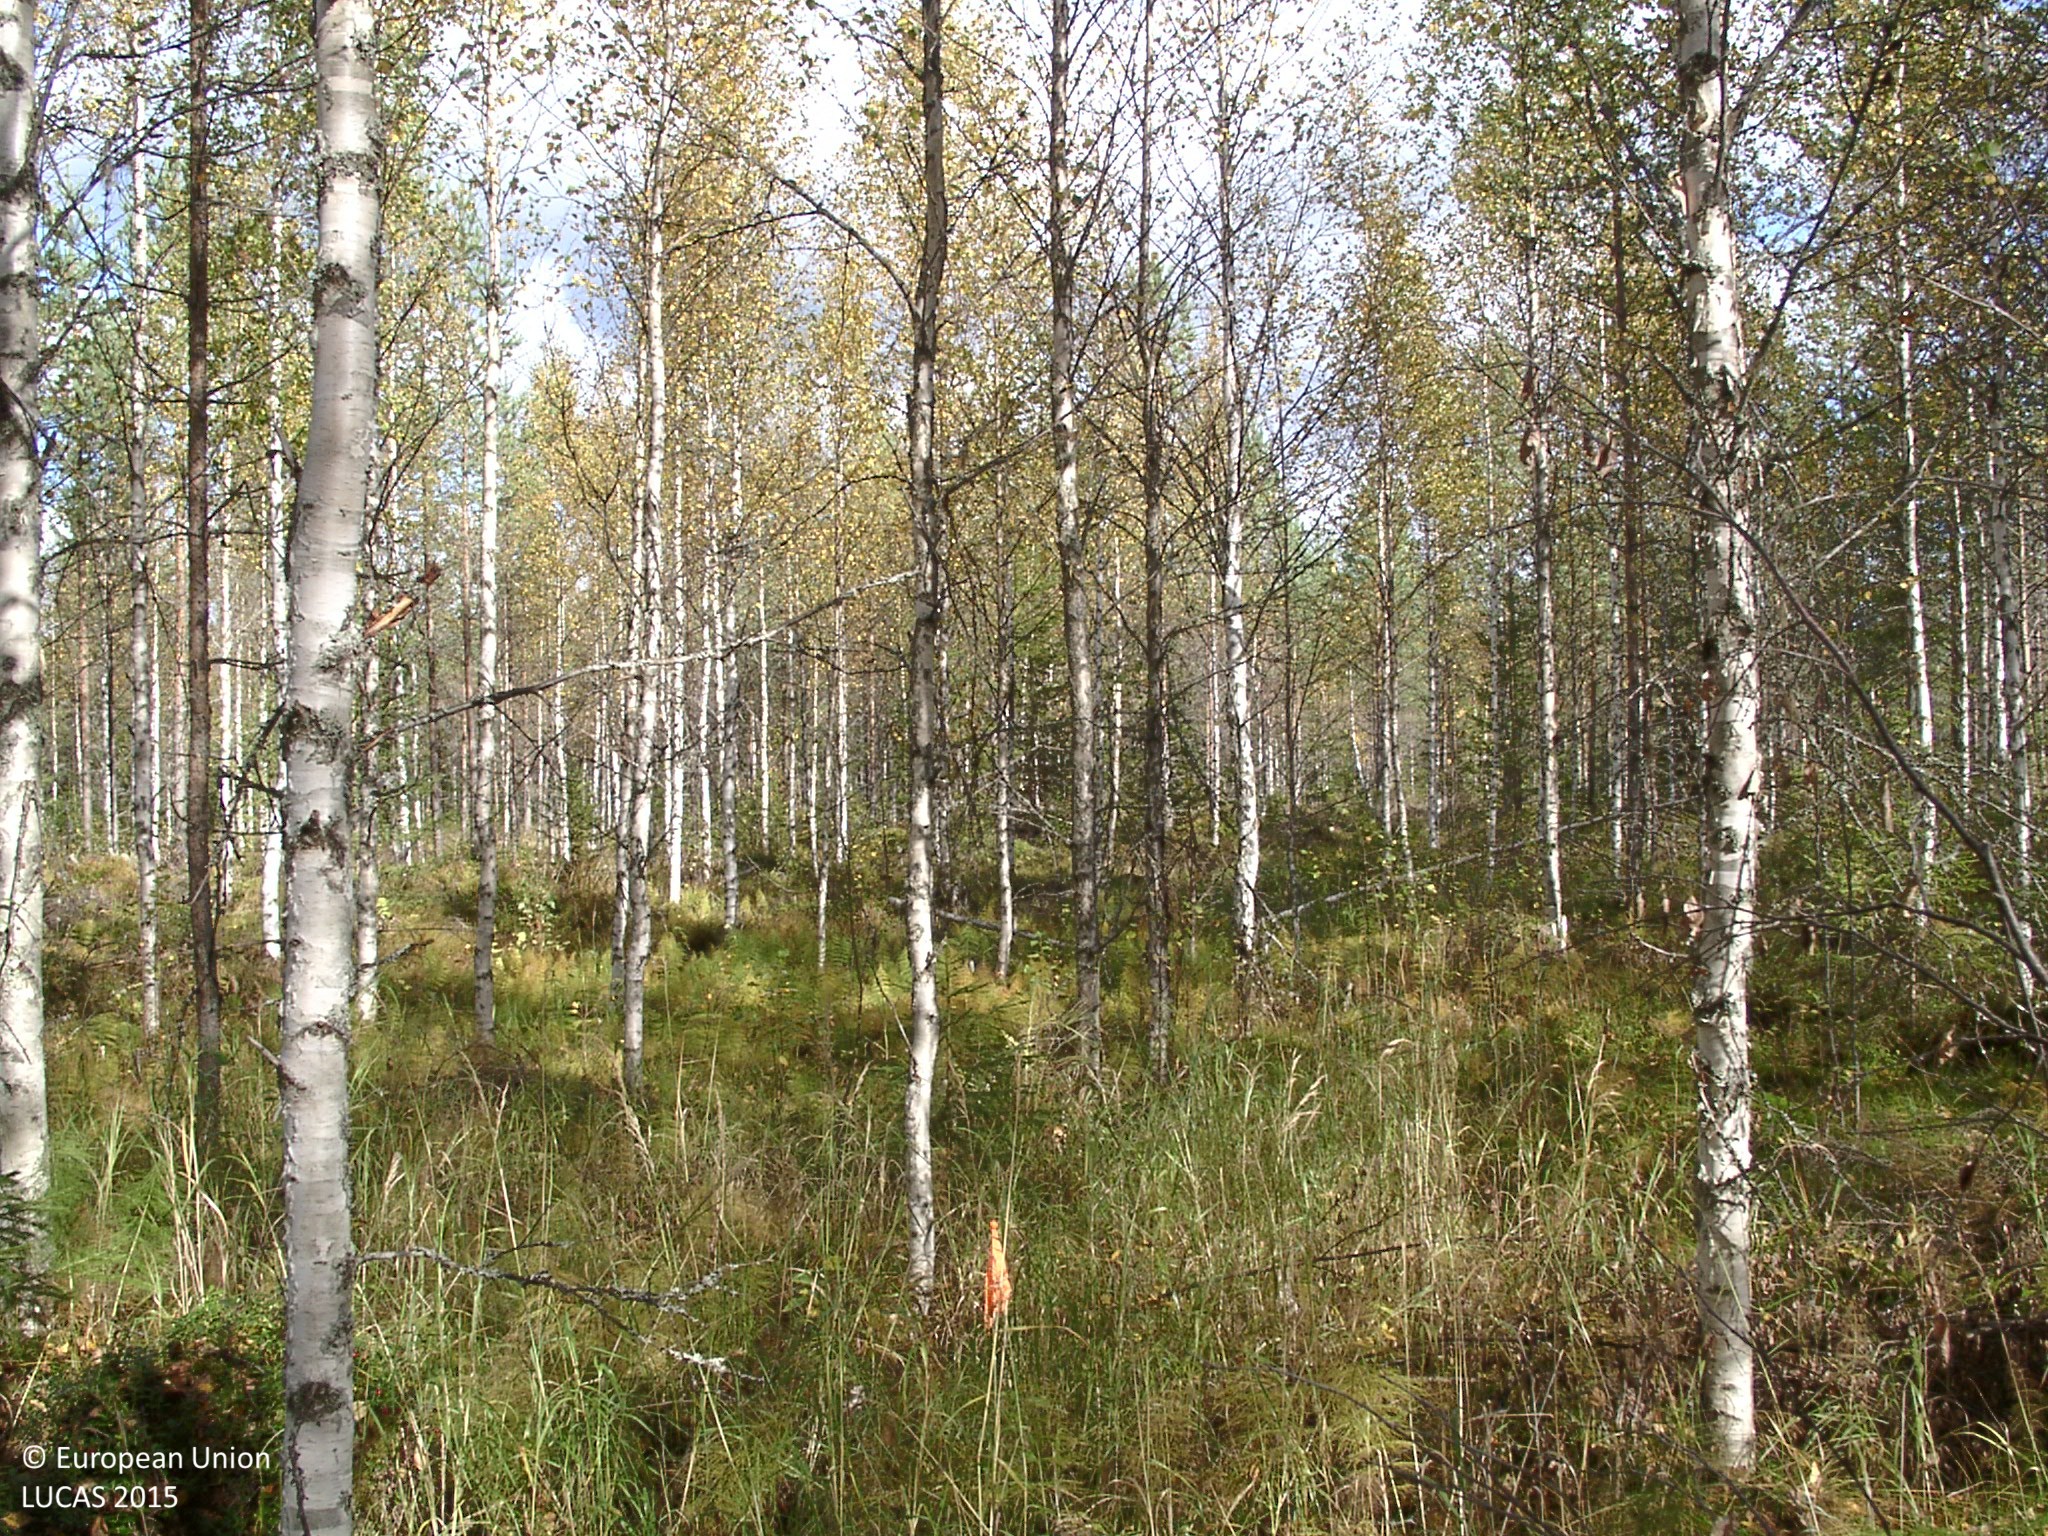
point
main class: Woodland
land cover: Pine dominated mixed woodland
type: boreal forest
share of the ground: 50 - 75 %
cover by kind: broadleaved forest trees 45 %, herbaceous plants 25 %, coniferous forest trees 15 %, lichens and mosses 10 %, shrubs 5 %
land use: Forestry
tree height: > 5 m
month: September
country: FI
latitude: 62.5182
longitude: 25.3564
